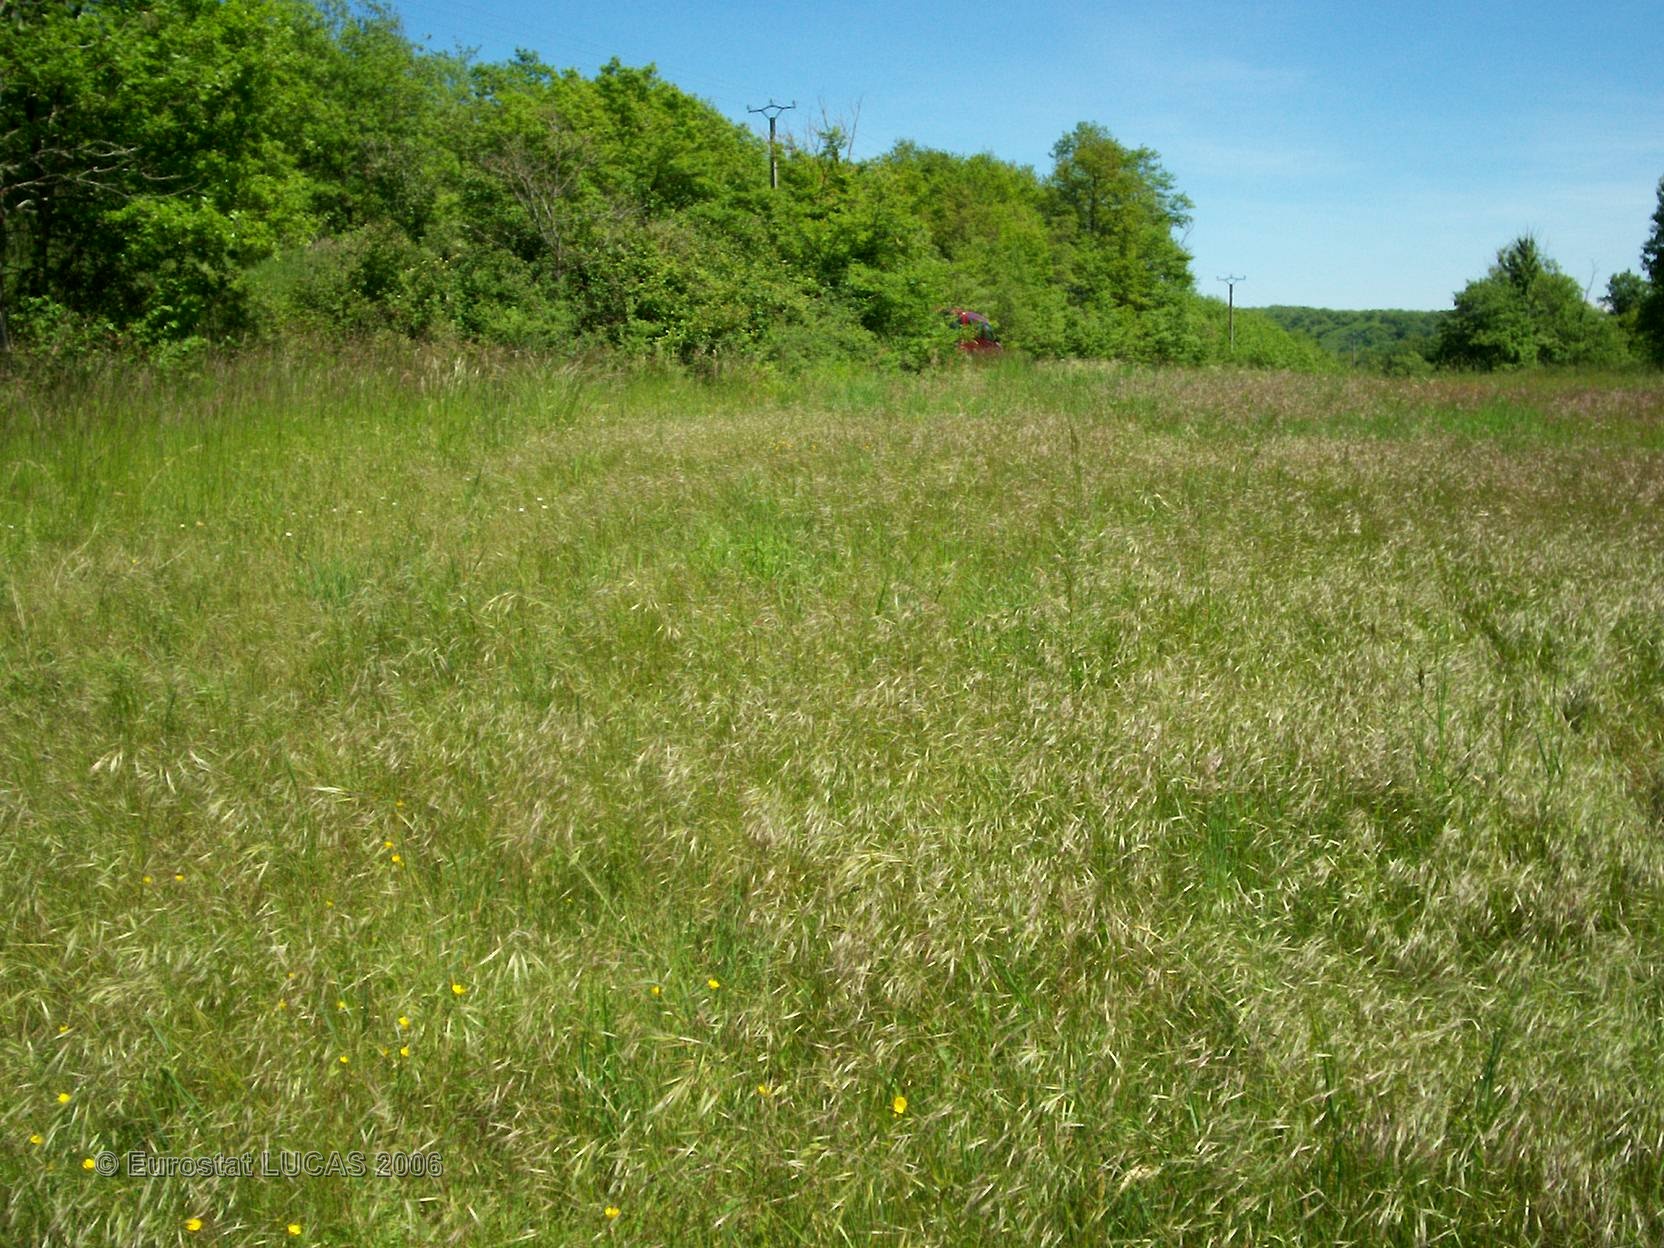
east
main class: Grassland
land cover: Grassland without tree/shrub cover
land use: Agriculture (excluding fallow land and kitchen gardens)
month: May
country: FR
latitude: 43.2066
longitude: 0.9066
